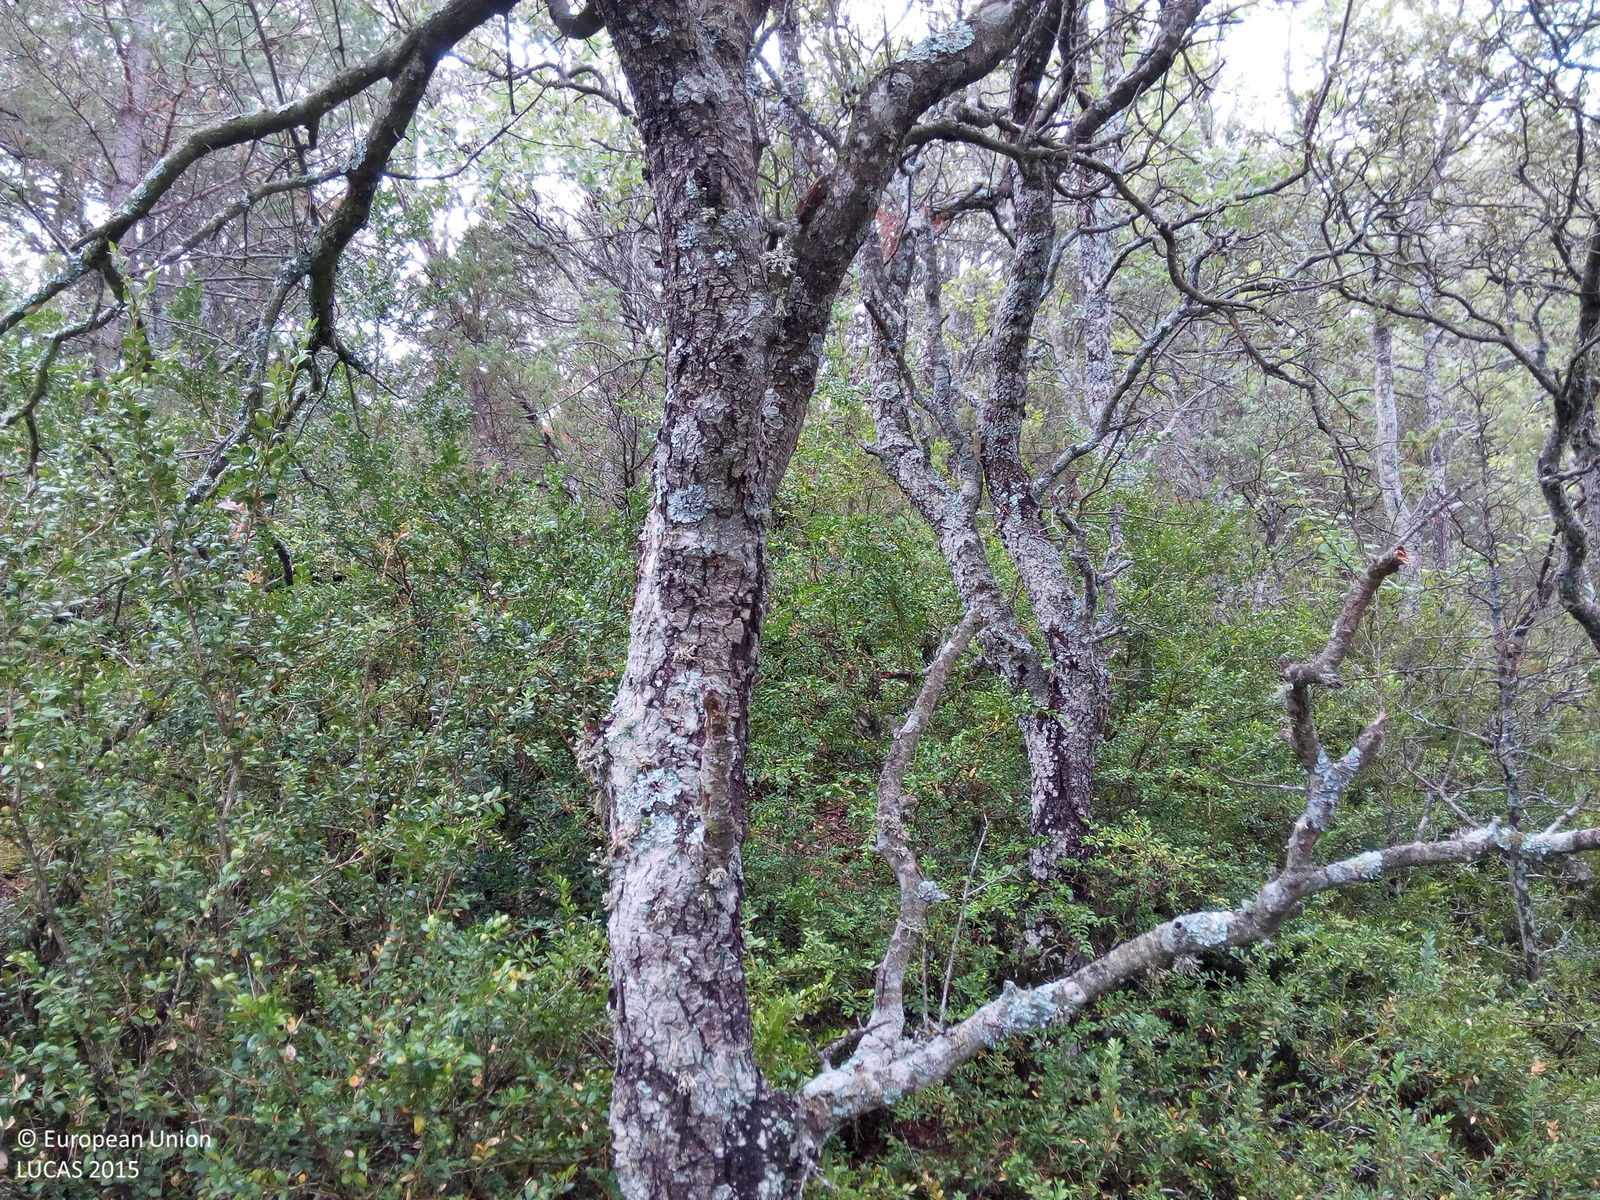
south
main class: Woodland
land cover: Pine dominated mixed woodland
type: coniferous forest of the mediterranean region
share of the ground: > 75 %
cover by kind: broadleaved forest trees 40 %, coniferous forest trees 30 %, shrubs 20 %, herbaceous plants 10 %
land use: Semi-natural and natural areas not in use
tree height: > 5 m
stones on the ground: < 10 %
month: August
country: ES
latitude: 42.1998
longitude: 0.6216
